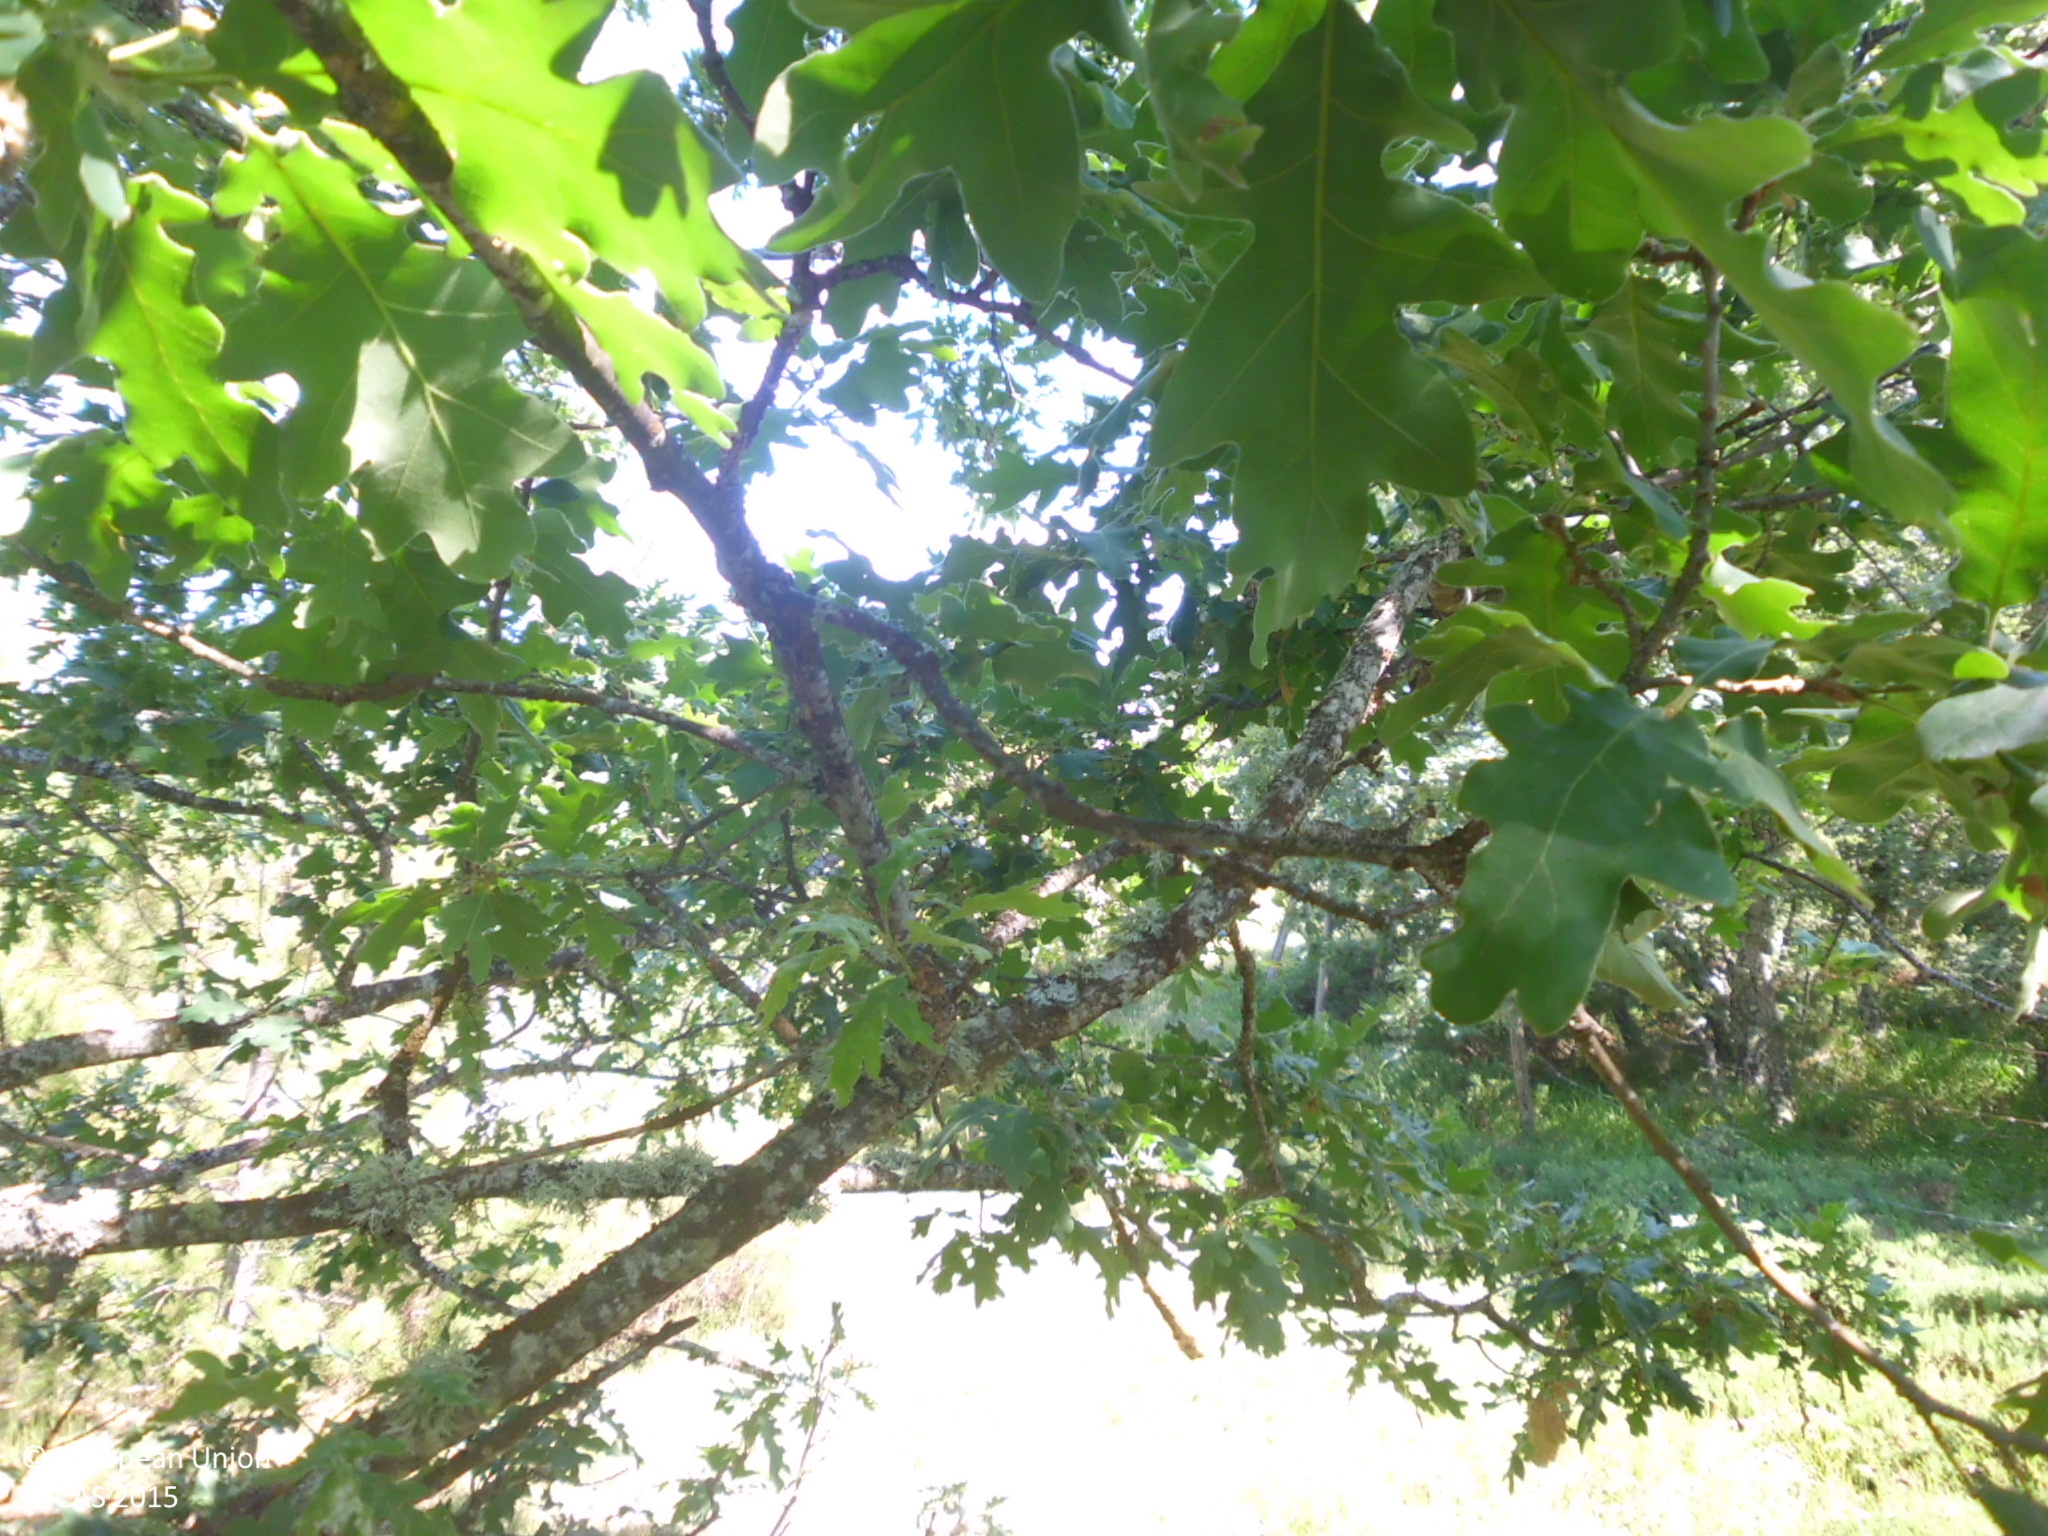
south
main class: Woodland
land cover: Broadleaved woodland
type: acidophilous oak and oak-birch forest
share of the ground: > 75 %
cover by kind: broadleaved forest trees 80 %, herbaceous plants 15 %, shrubs 5 %
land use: Forestry
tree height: > 5 m
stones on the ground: < 10 %
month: June
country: ES
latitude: 42.8062
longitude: -4.4213
